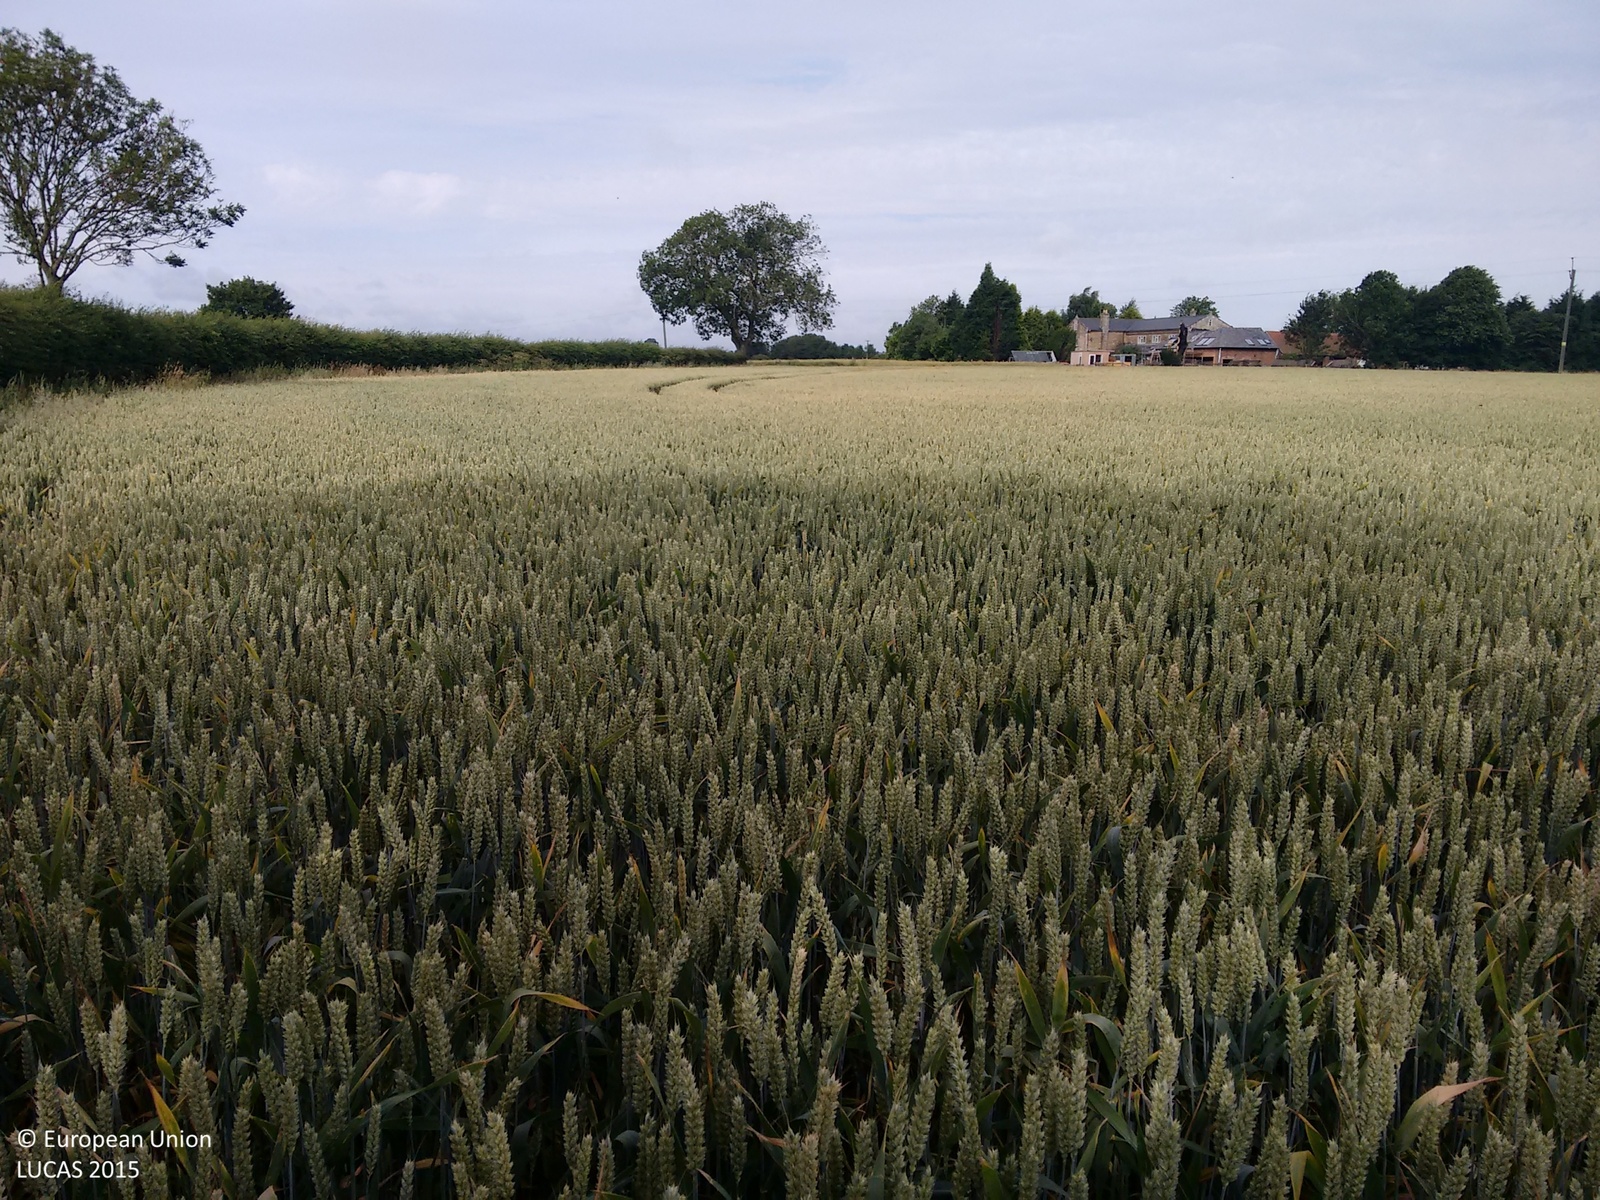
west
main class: Cropland
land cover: Common wheat
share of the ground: > 75 %
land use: Agriculture (excluding fallow land and kitchen gardens)
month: July
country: GB
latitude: 52.6136
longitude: -0.7485
